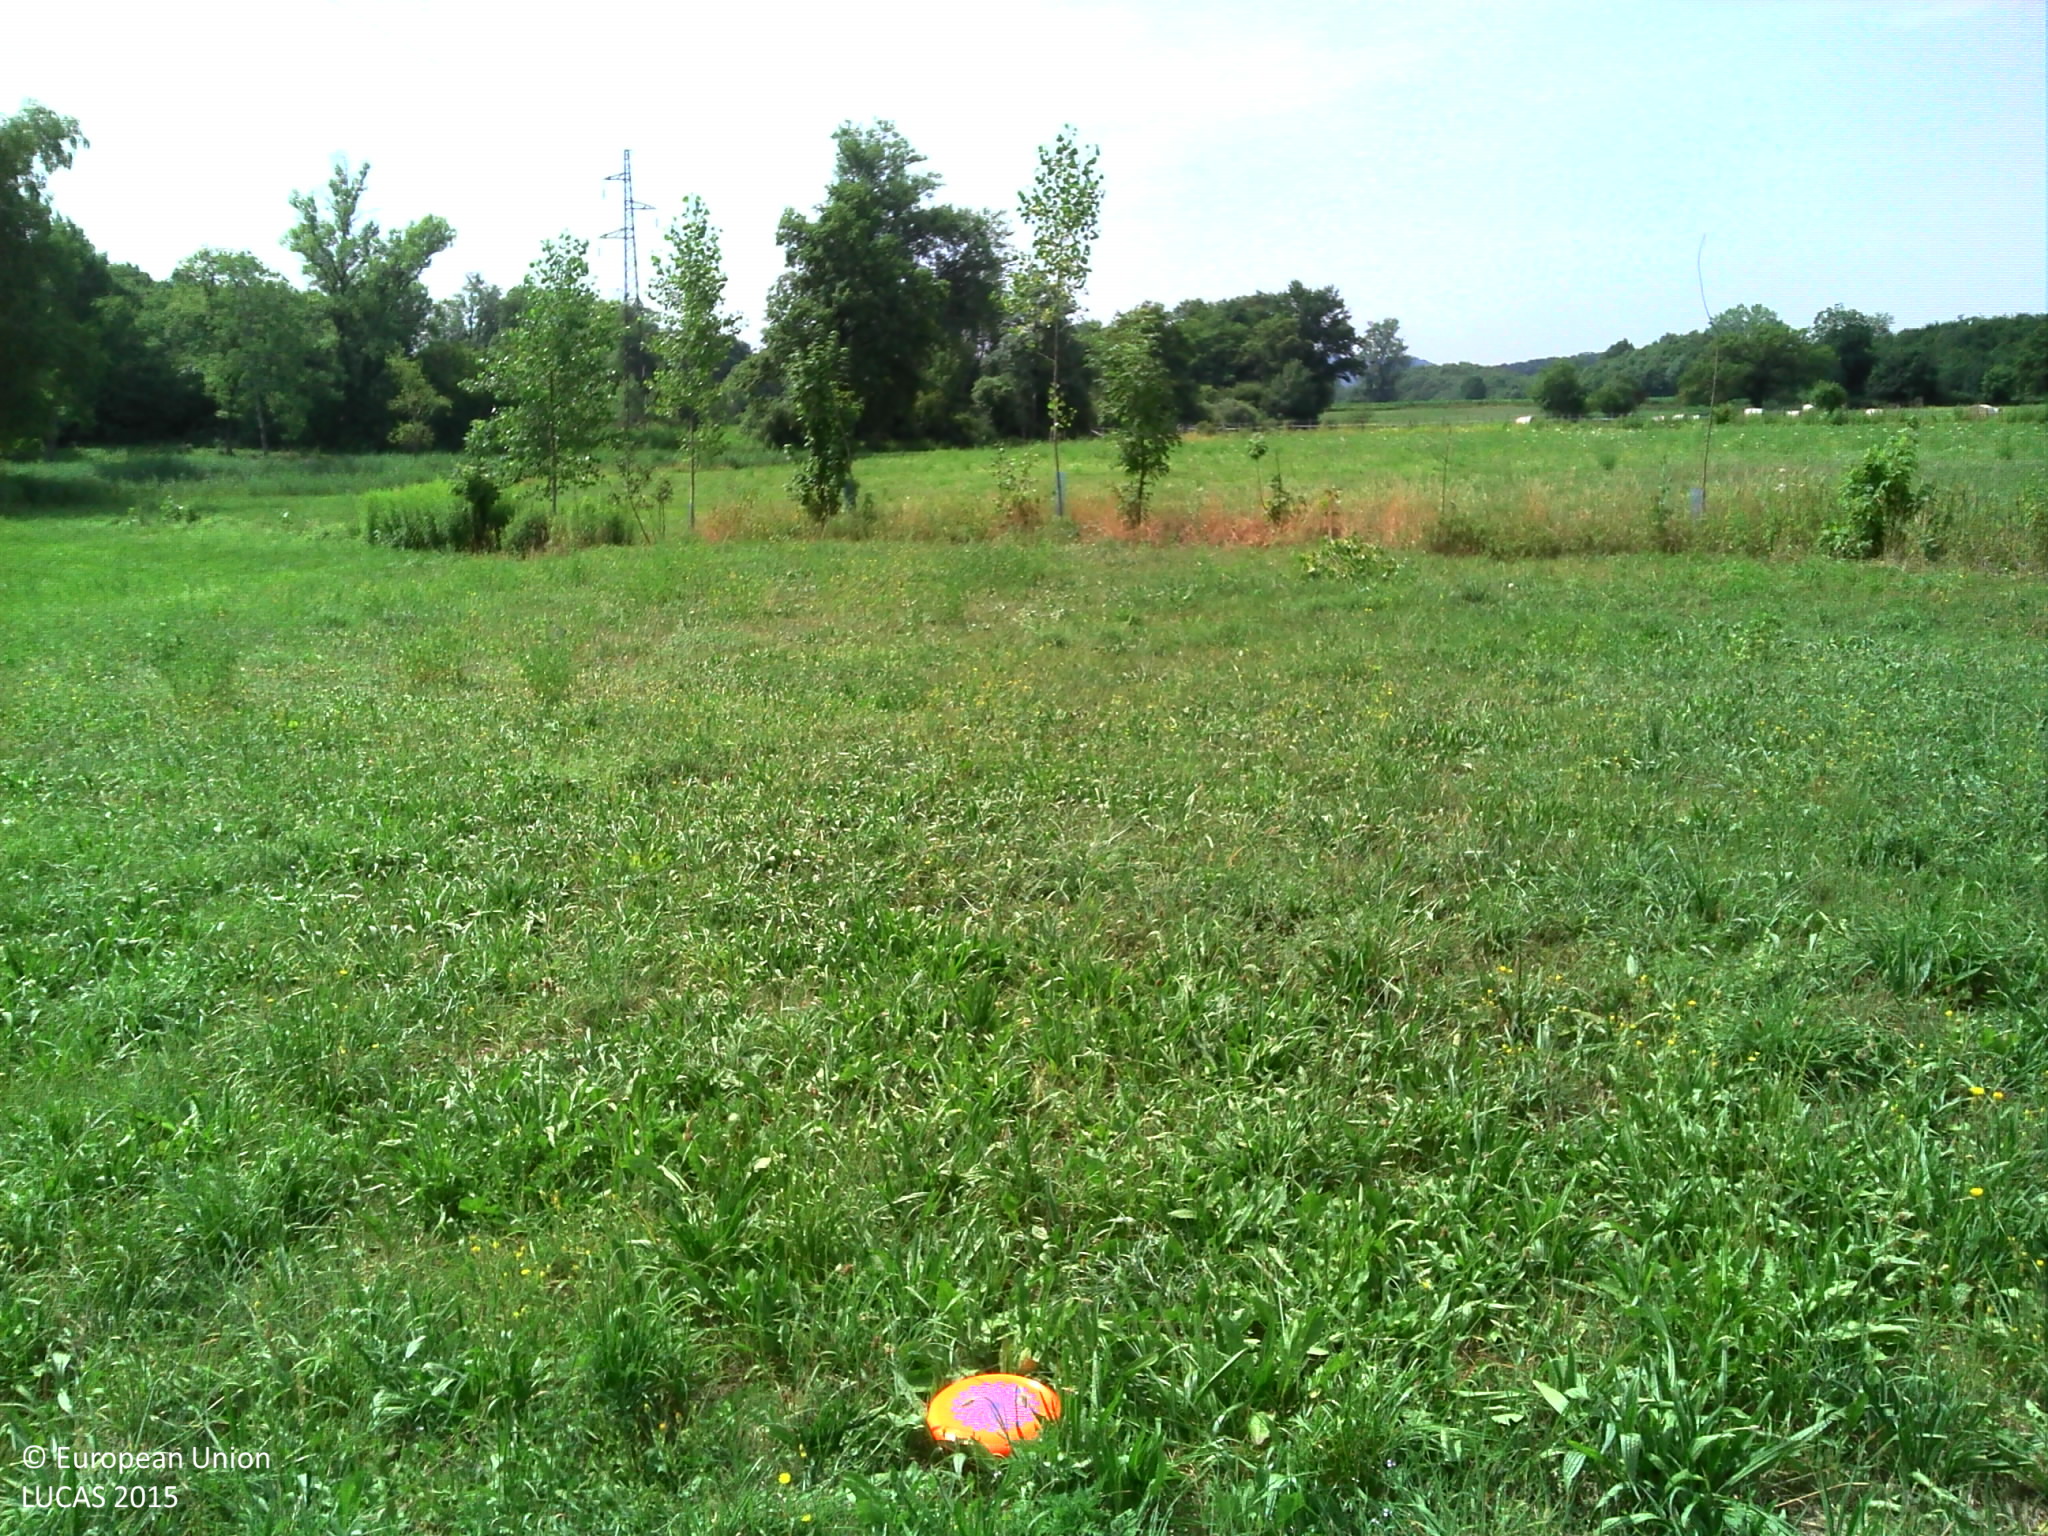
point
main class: Grassland
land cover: Grassland with sparse tree/shrub cover
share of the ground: > 75 %
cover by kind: herbaceous plants 95 %, broadleaved forest trees 5 %
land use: Agriculture (excluding fallow land and kitchen gardens)
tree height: > 5 m
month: July
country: FR
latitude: 45.7298
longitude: 5.4167
